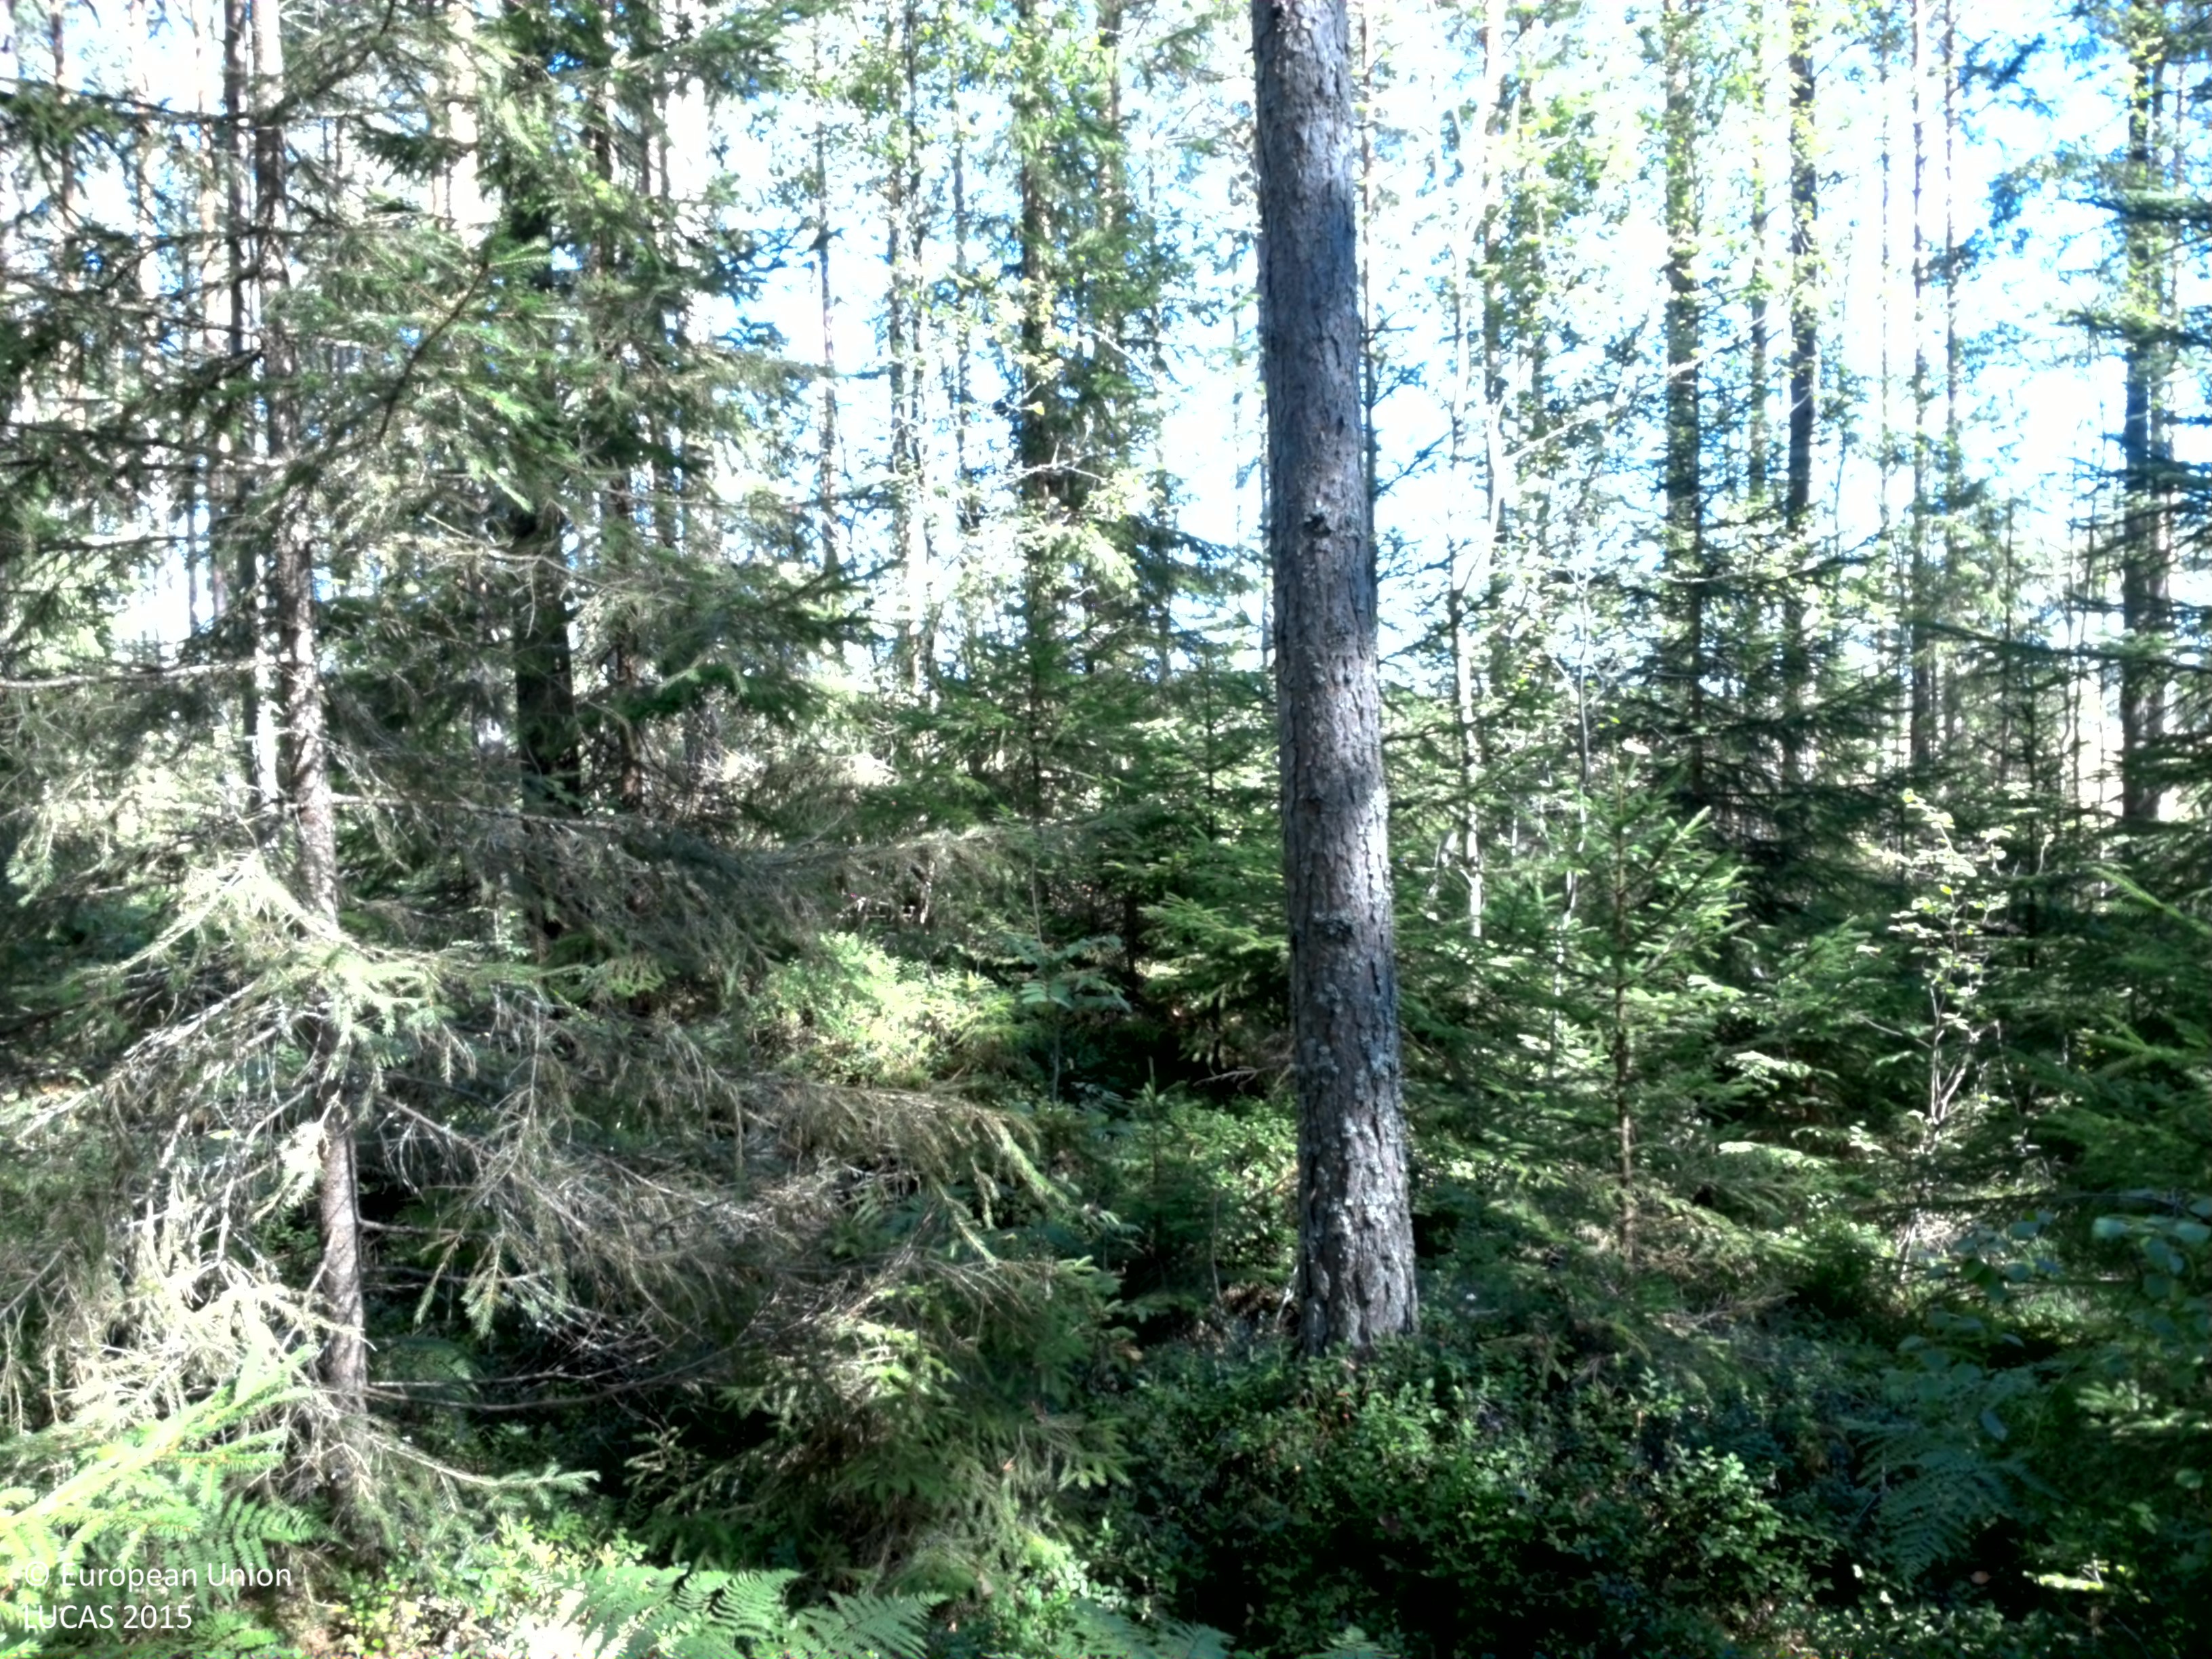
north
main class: Woodland
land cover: Other coniferous woodland
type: boreal forest
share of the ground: > 75 %
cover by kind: coniferous forest trees 75 %, shrubs 15 %, broadleaved forest trees 5 %, herbaceous plants 5 %
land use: Forestry
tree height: > 5 m
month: August
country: SE
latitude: 60.0782
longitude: 17.0187
